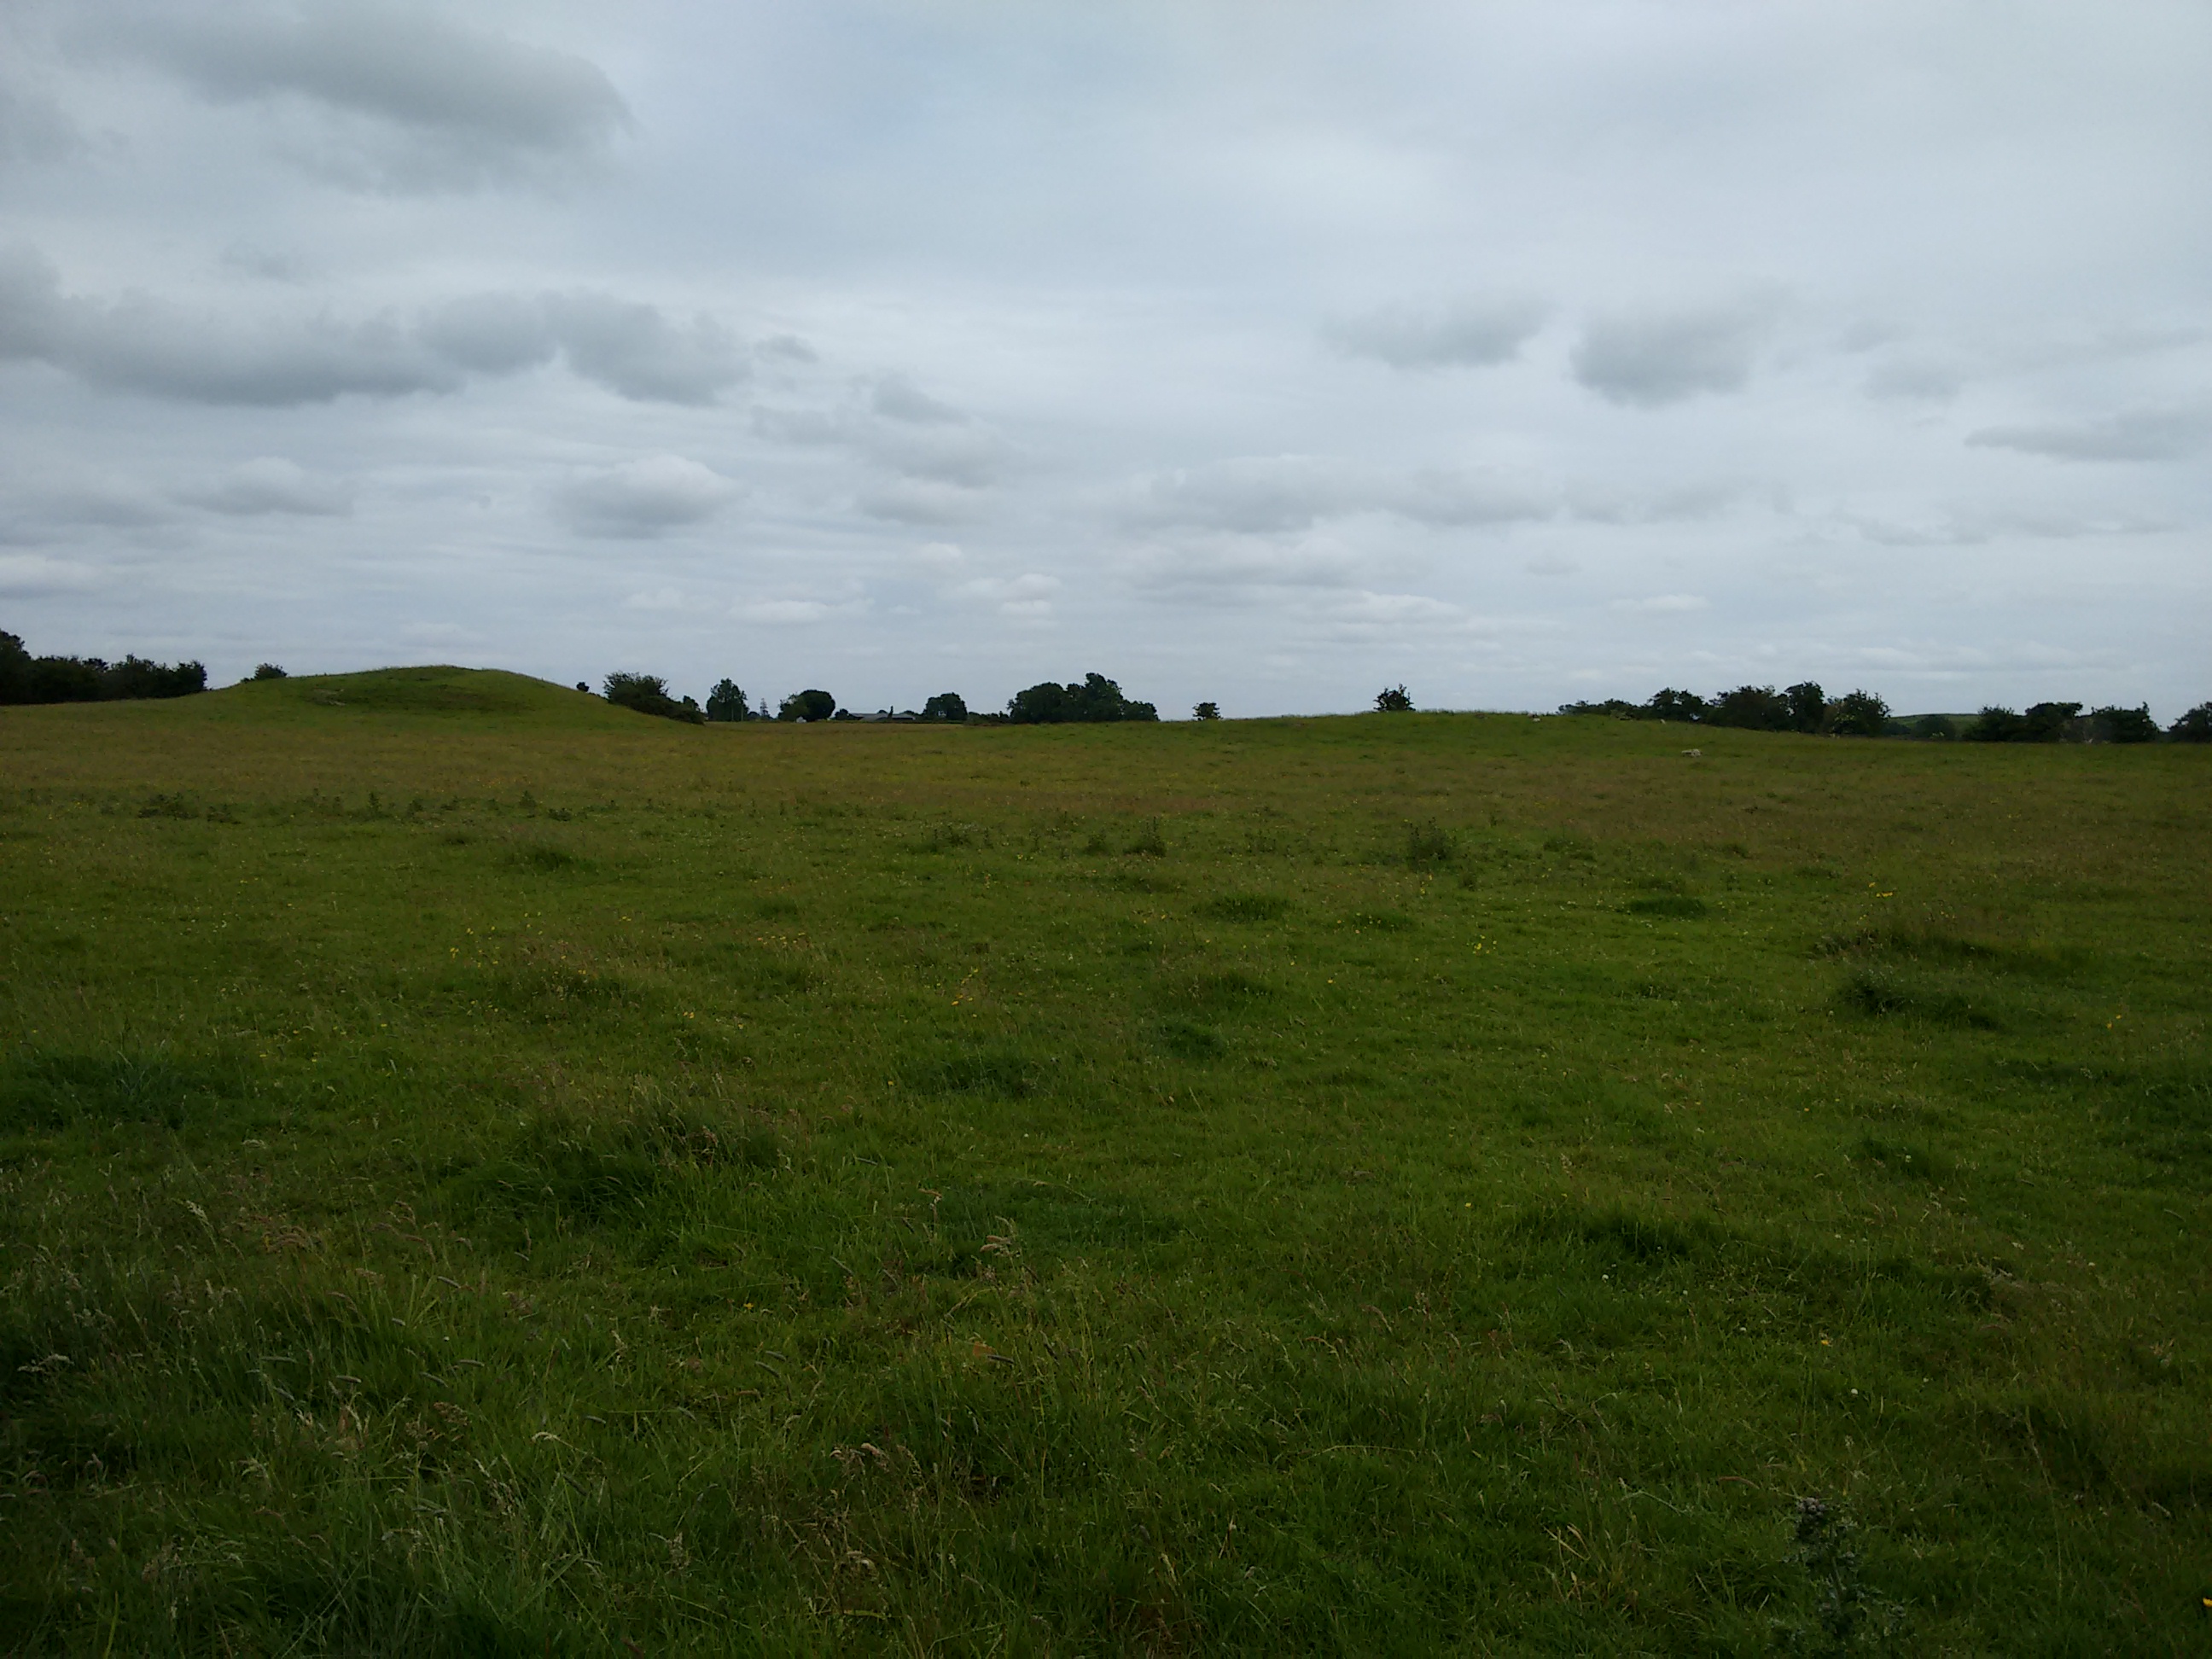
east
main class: Grassland
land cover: Grassland without tree/shrub cover
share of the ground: > 75 %
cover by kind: herbaceous plants 100 %
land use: Agriculture (excluding fallow land and kitchen gardens)
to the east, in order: Managed hedges; Fences; Grassland without tree/shrub cover; Rock outcrops; Grassland without tree/shrub cover
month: June
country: IE
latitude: 53.4070
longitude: -7.5957
